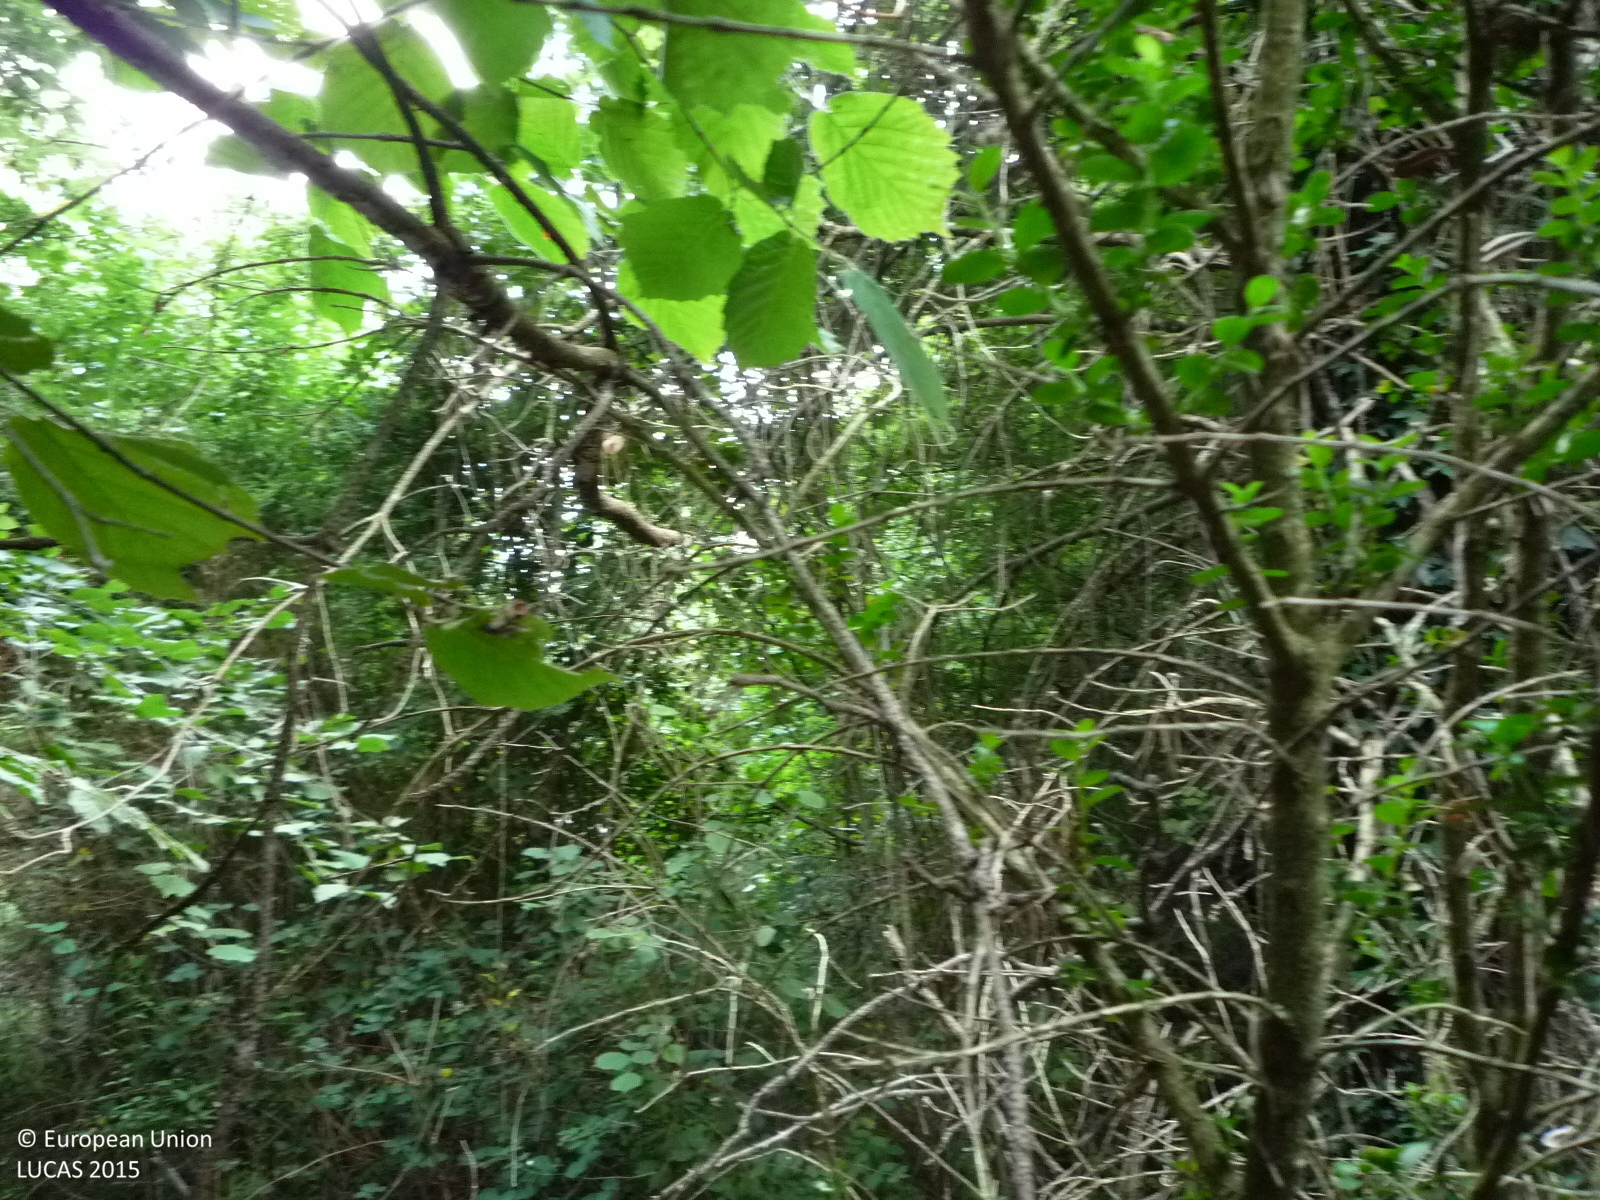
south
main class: Woodland
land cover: Pine dominated mixed woodland
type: coniferous forest of the mediterranean region
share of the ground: > 75 %
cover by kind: coniferous forest trees 55 %, broadleaved forest trees 45 %
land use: Semi-natural and natural areas not in use
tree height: > 5 m
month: July
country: ES
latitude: 42.1843
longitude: 2.1310
